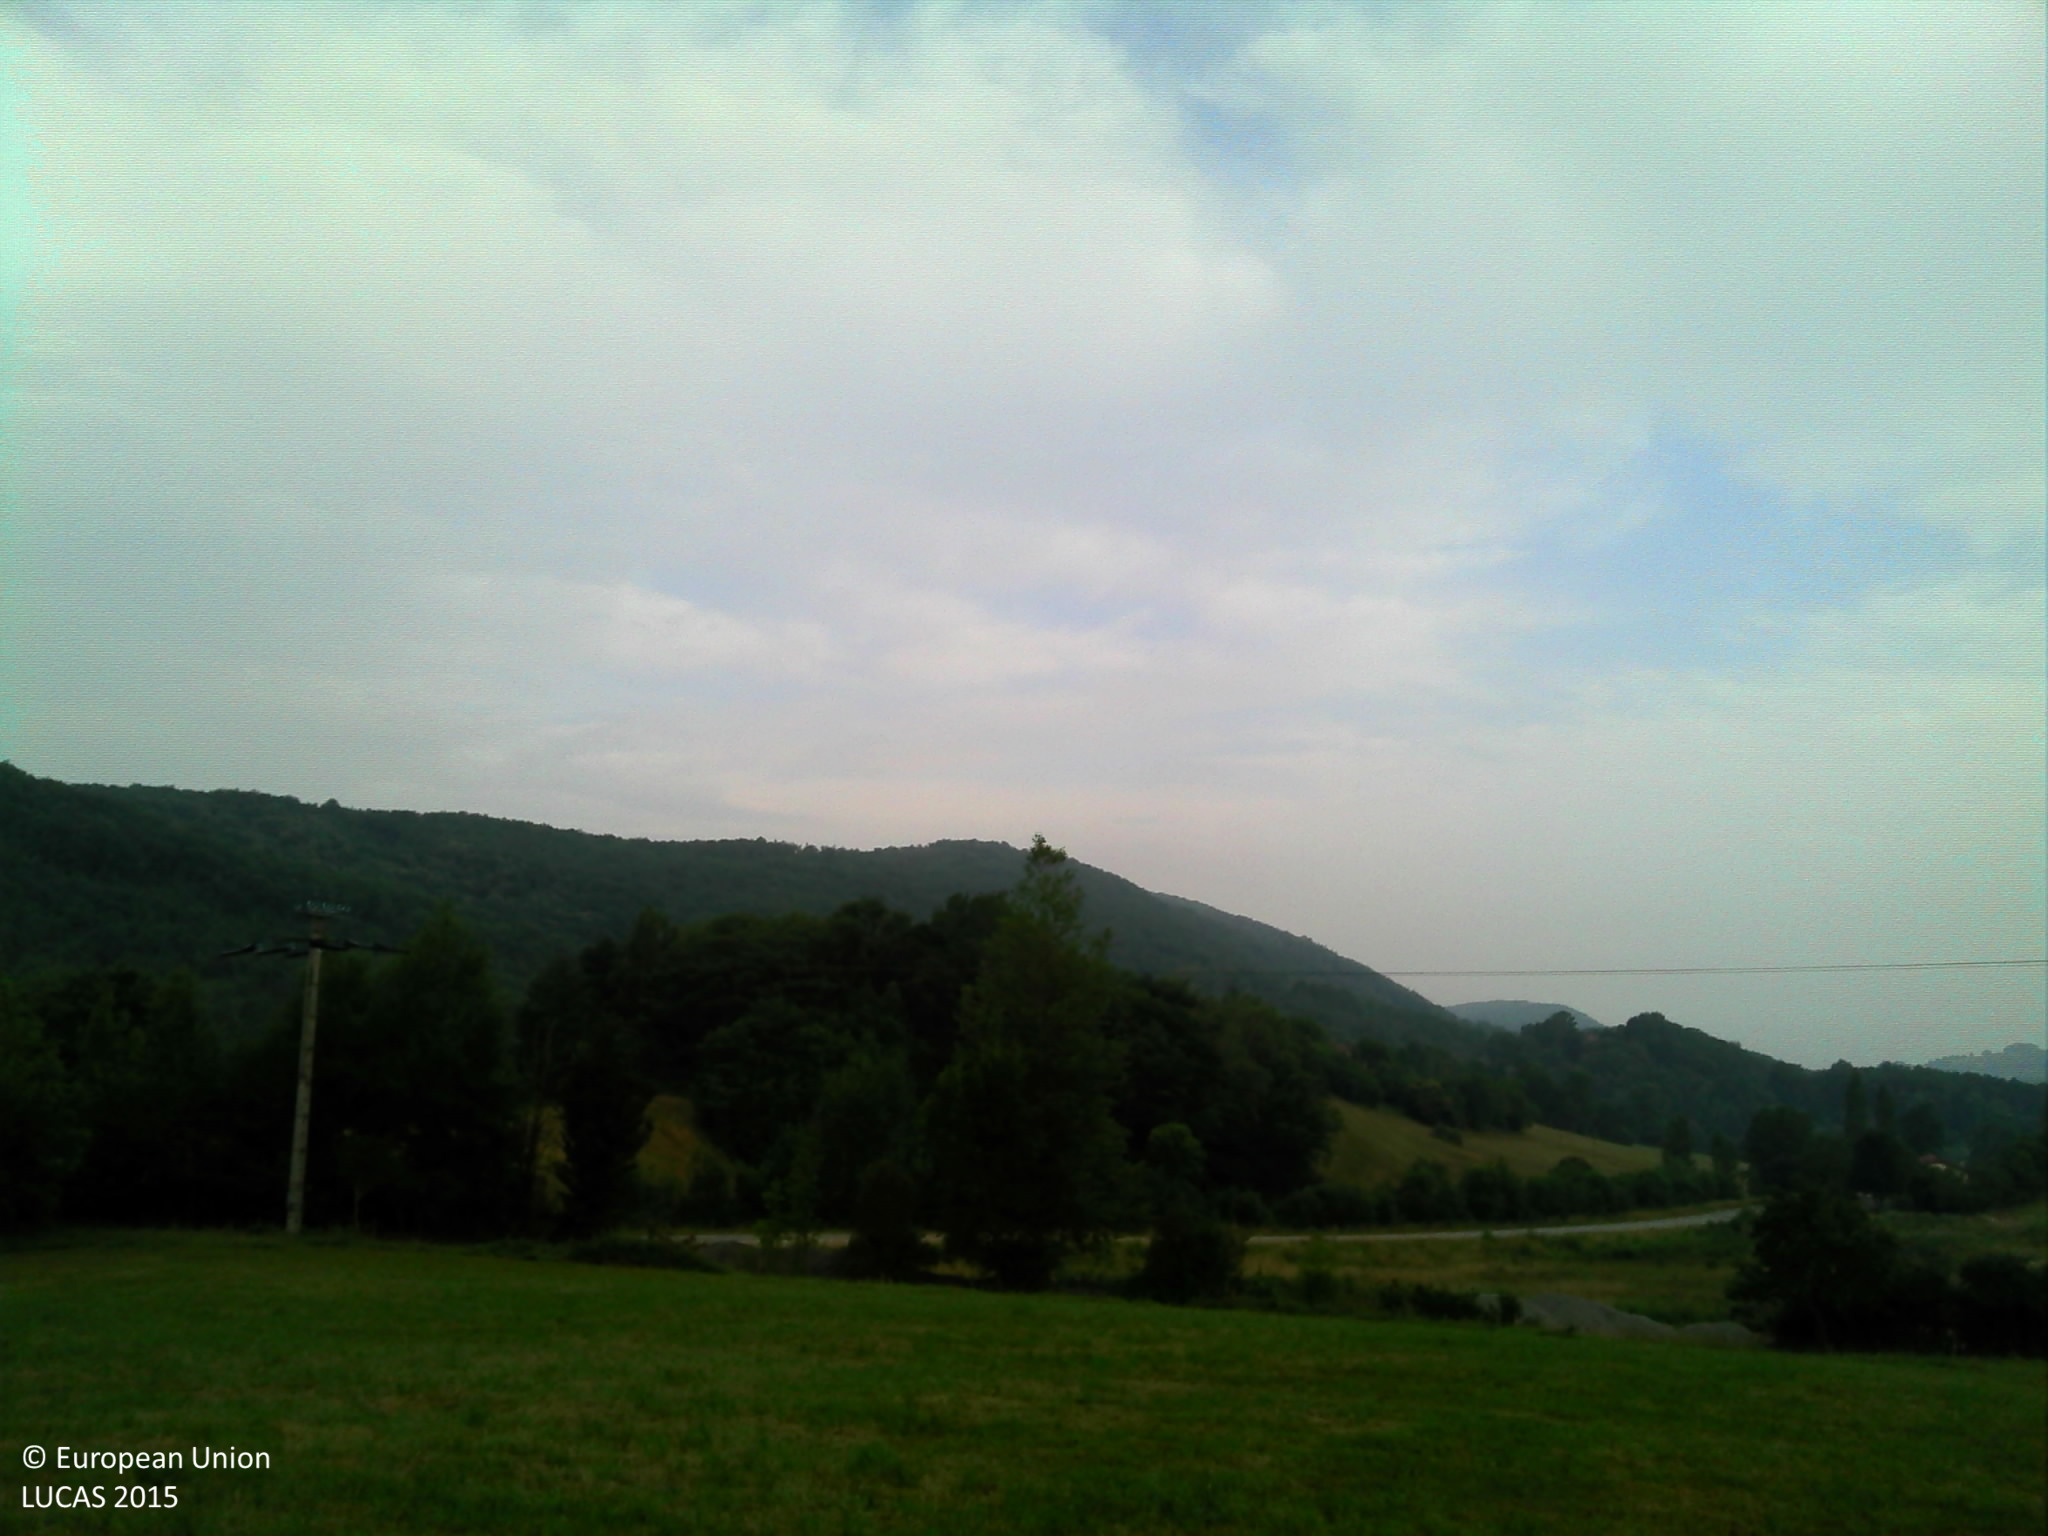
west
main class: Cropland
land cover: Temporary grasslands
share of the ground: > 75 %
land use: Agriculture (excluding fallow land and kitchen gardens)
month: July
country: FR
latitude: 43.0581
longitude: 1.4971
